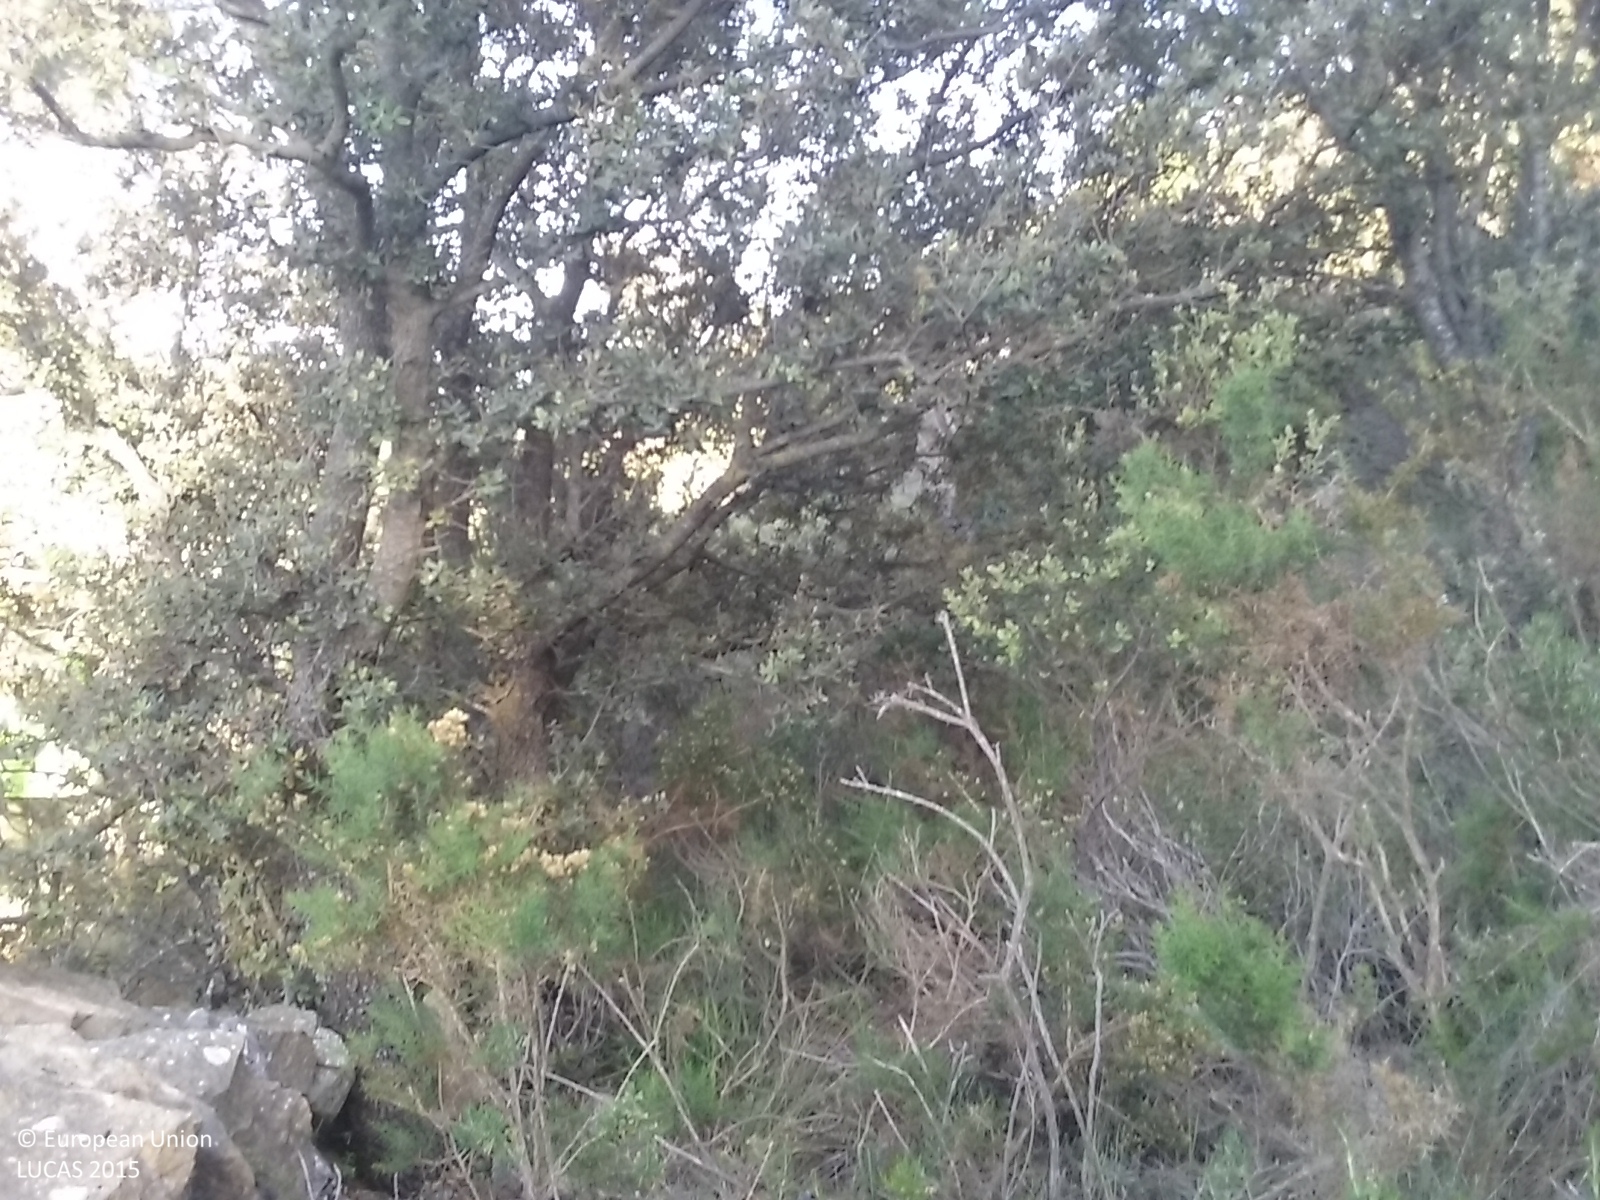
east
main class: Woodland
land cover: Broadleaved woodland
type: broadleaved evergreen forest
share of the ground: 50 - 75 %
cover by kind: broadleaved forest trees 80 %, shrubs 15 %
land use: Semi-natural and natural areas not in use
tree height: > 5 m
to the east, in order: Broadleaved woodland; Rocks and stones; Broadleaved woodland; Rocks and stones; Broadleaved woodland; Shrubland with sparse tree cover; Dry stone walls; Grassland with sparse tree/shrub cover; Dry stone walls; Grassland with sparse tree/shrub cover
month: May
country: ES
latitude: 40.3825
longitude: -0.0999
